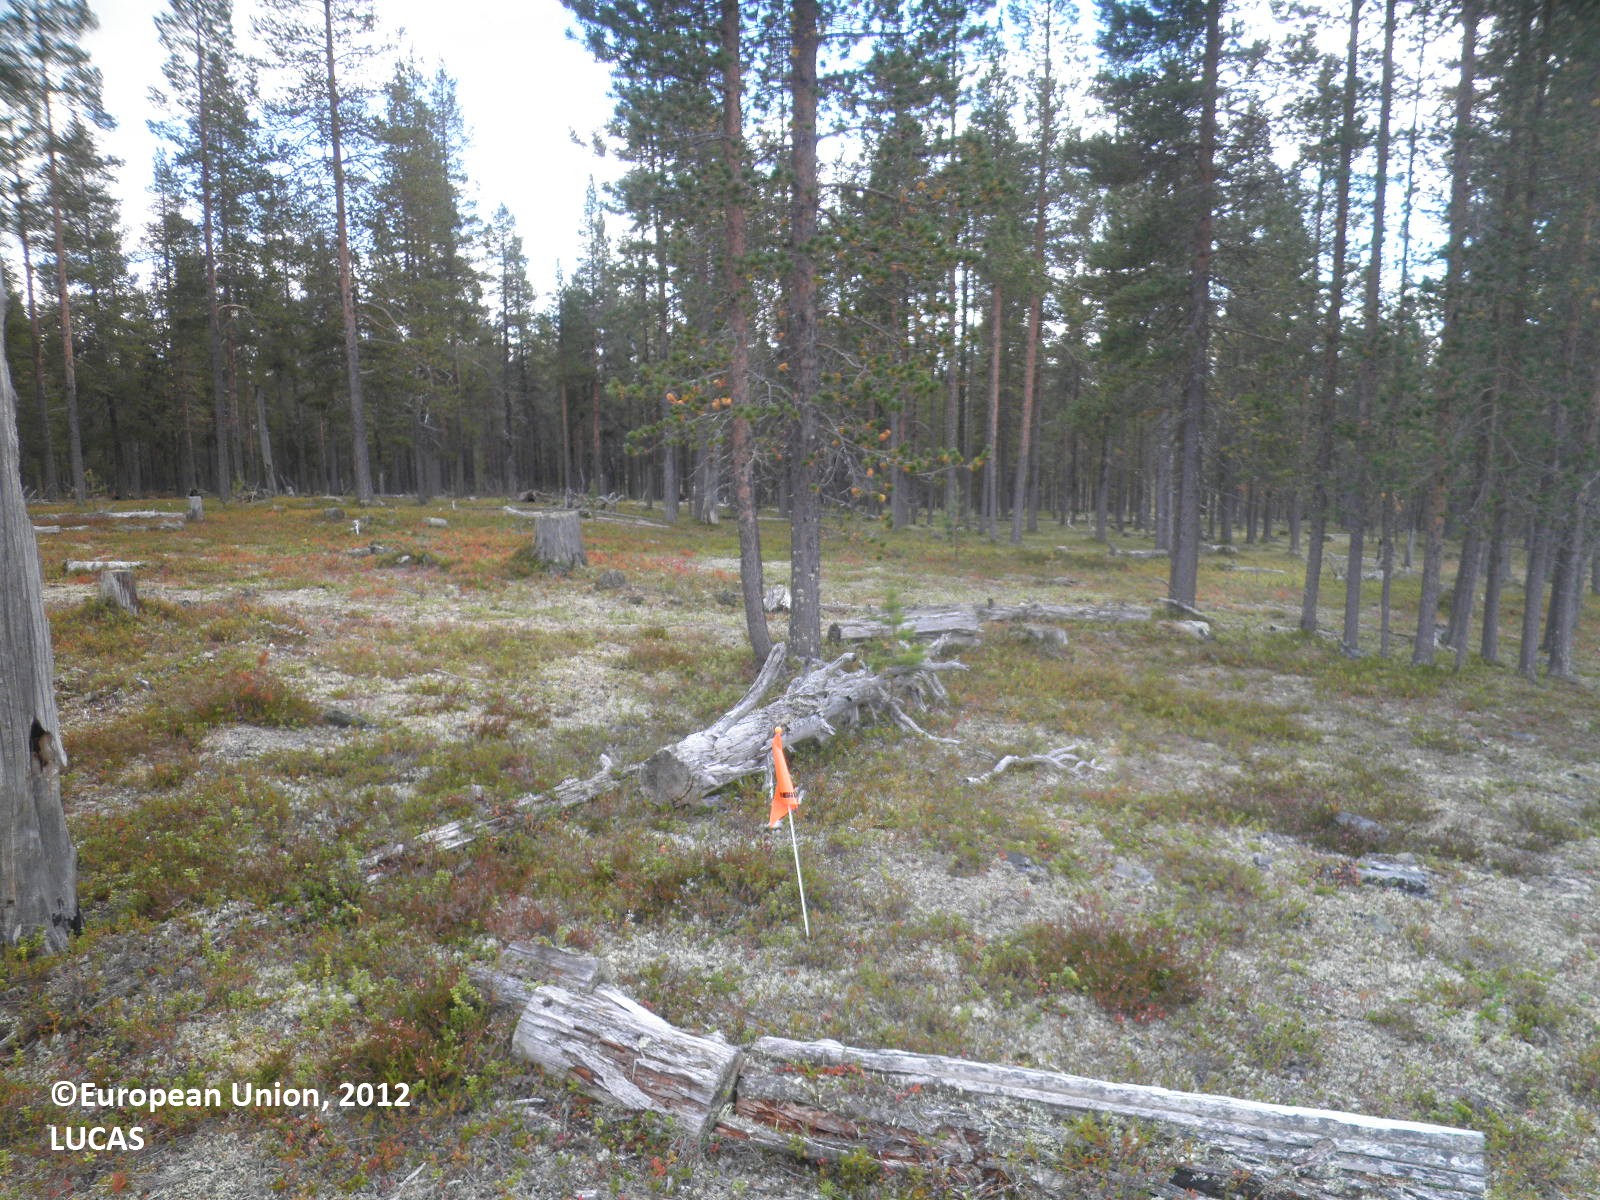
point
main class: Shrubland
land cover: Shrubland with sparse tree cover
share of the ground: > 75 %
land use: Forestry
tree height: > 5 m
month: August
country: FI
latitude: 68.0224
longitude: 28.2360
